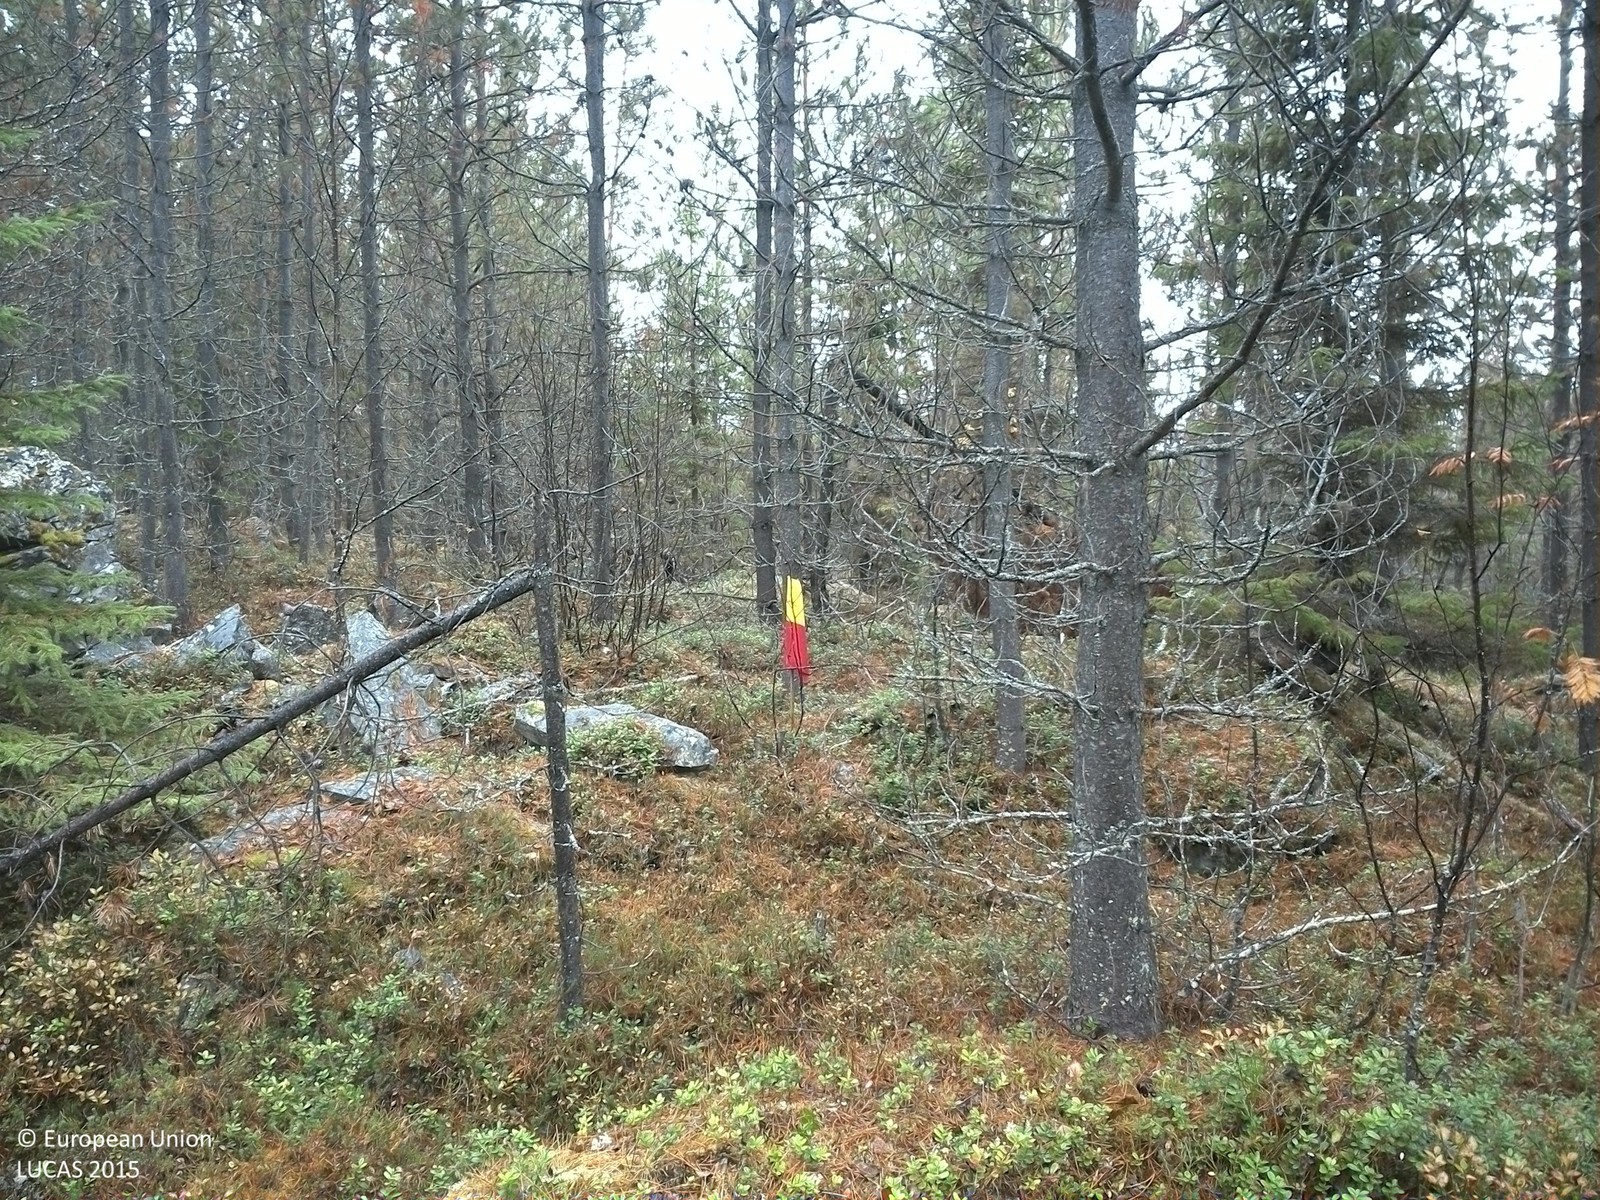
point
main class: Woodland
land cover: Pine dominated coniferous woodland
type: exotic forest
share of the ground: 25 - 50 %
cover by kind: coniferous forest trees 40 %, shrubs 35 %, lichens and mosses 15 %, broadleaved forest trees 5 %, consolidated bare surface 5 %
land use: Forestry
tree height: > 5 m
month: October
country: SE
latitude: 64.3405
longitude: 15.4560
